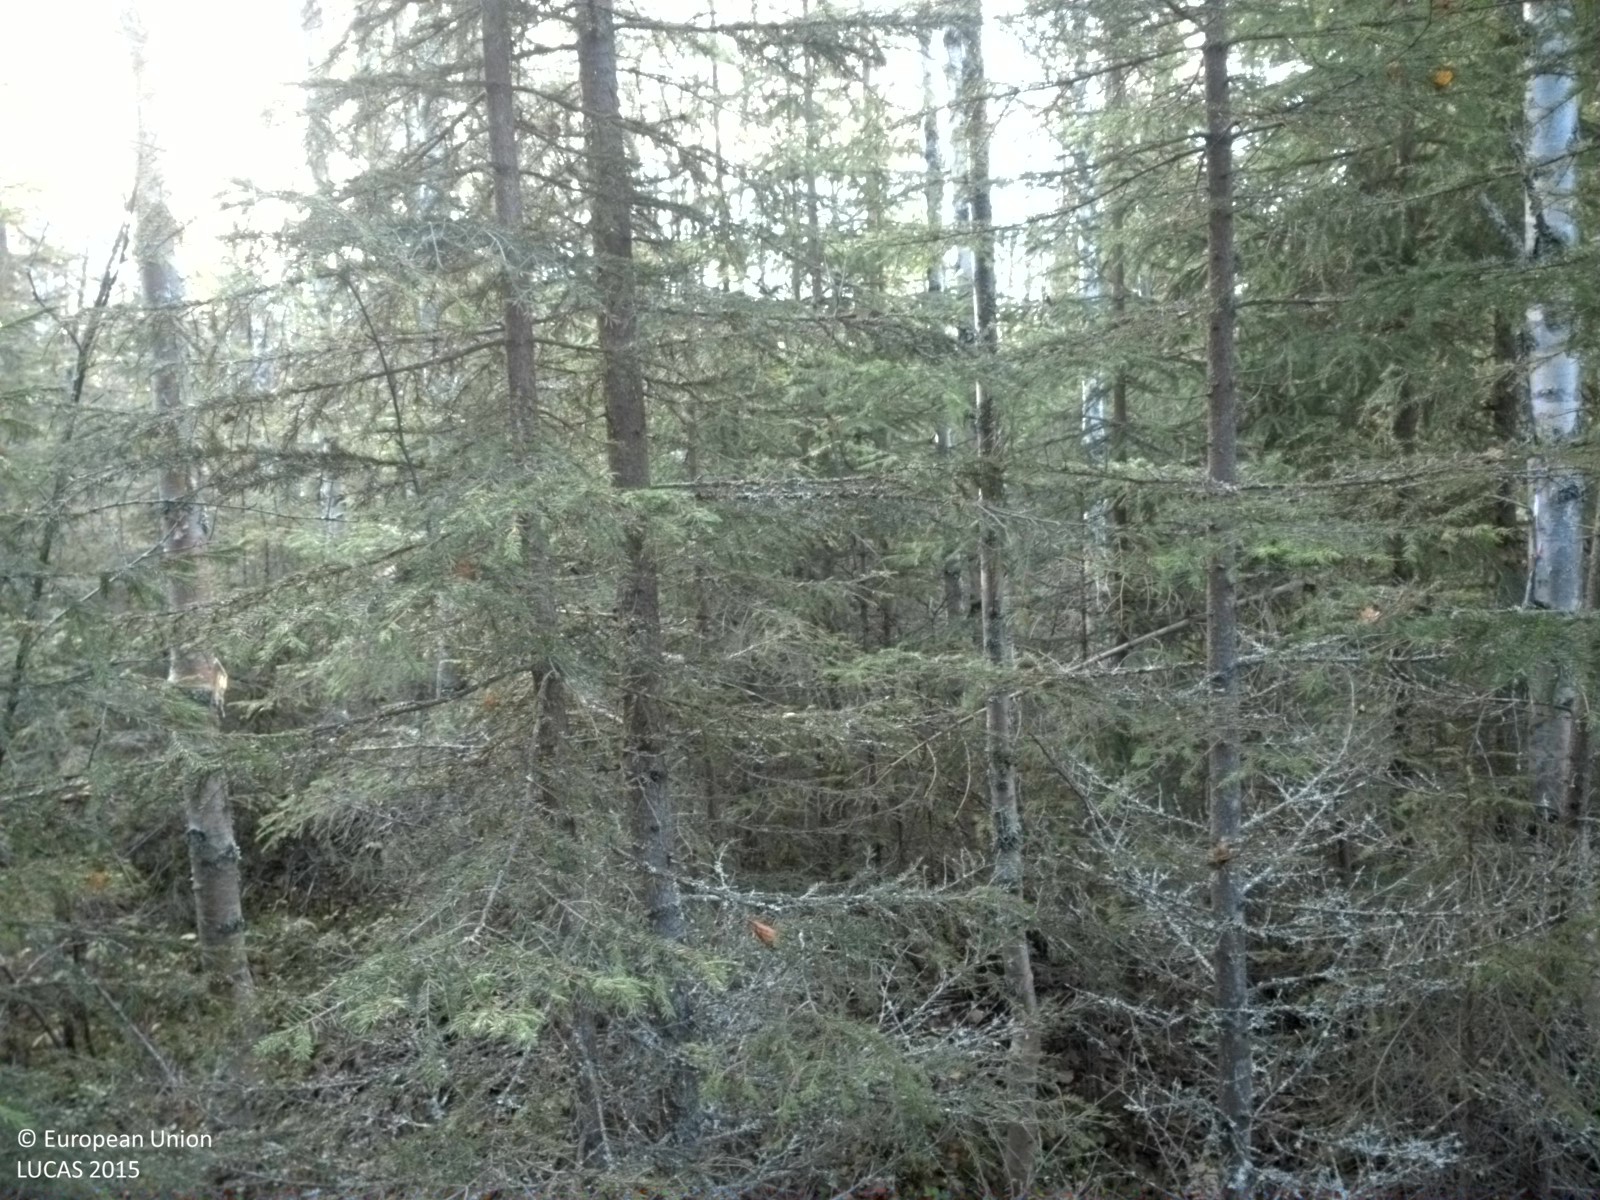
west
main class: Woodland
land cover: Spruce dominated mixed woodland
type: boreal forest
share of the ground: 50 - 75 %
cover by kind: coniferous forest trees 40 %, shrubs 35 %, broadleaved forest trees 25 %
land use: Forestry
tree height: > 5 m
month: October
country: SE
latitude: 65.9974
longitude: 22.2023
